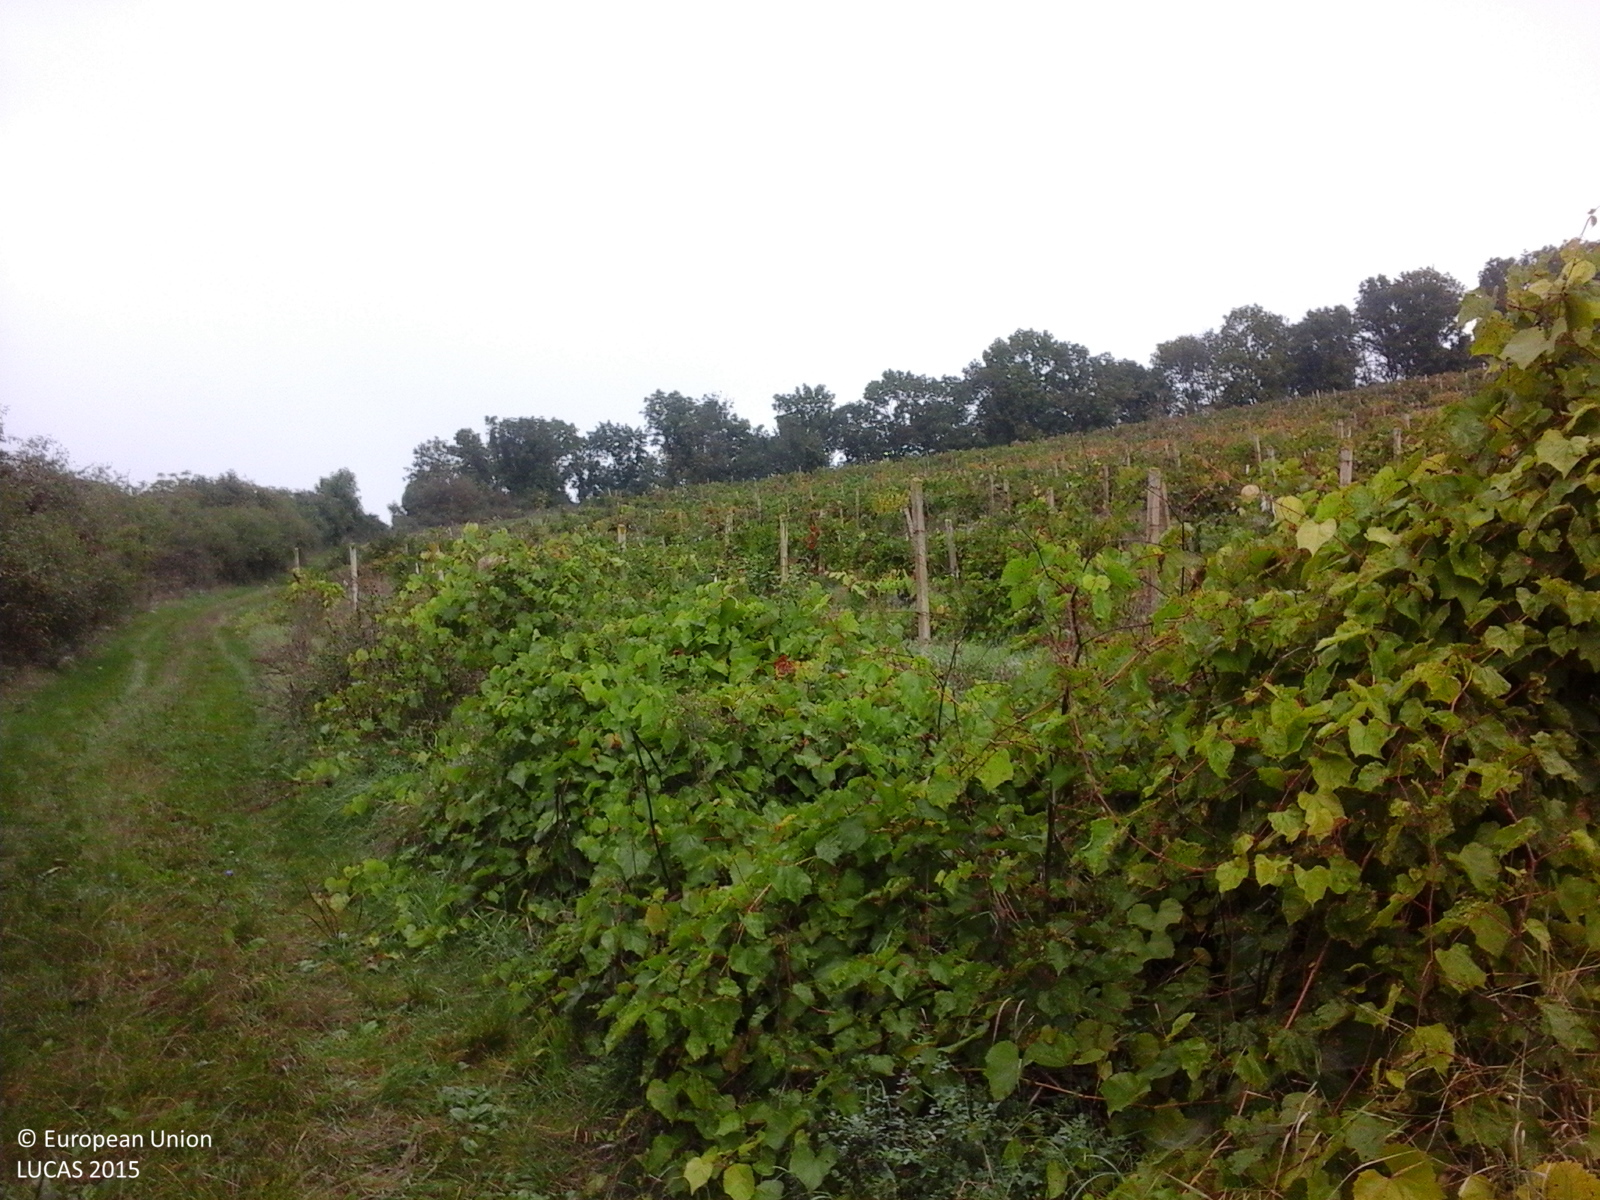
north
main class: Shrubland
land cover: Shrubland with sparse tree cover
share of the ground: > 75 %
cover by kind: shrubs 95 %, broadleaved forest trees 5 %
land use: Semi-natural and natural areas not in use
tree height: > 5 m
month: October
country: RO
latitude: 46.6478
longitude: 24.4191
